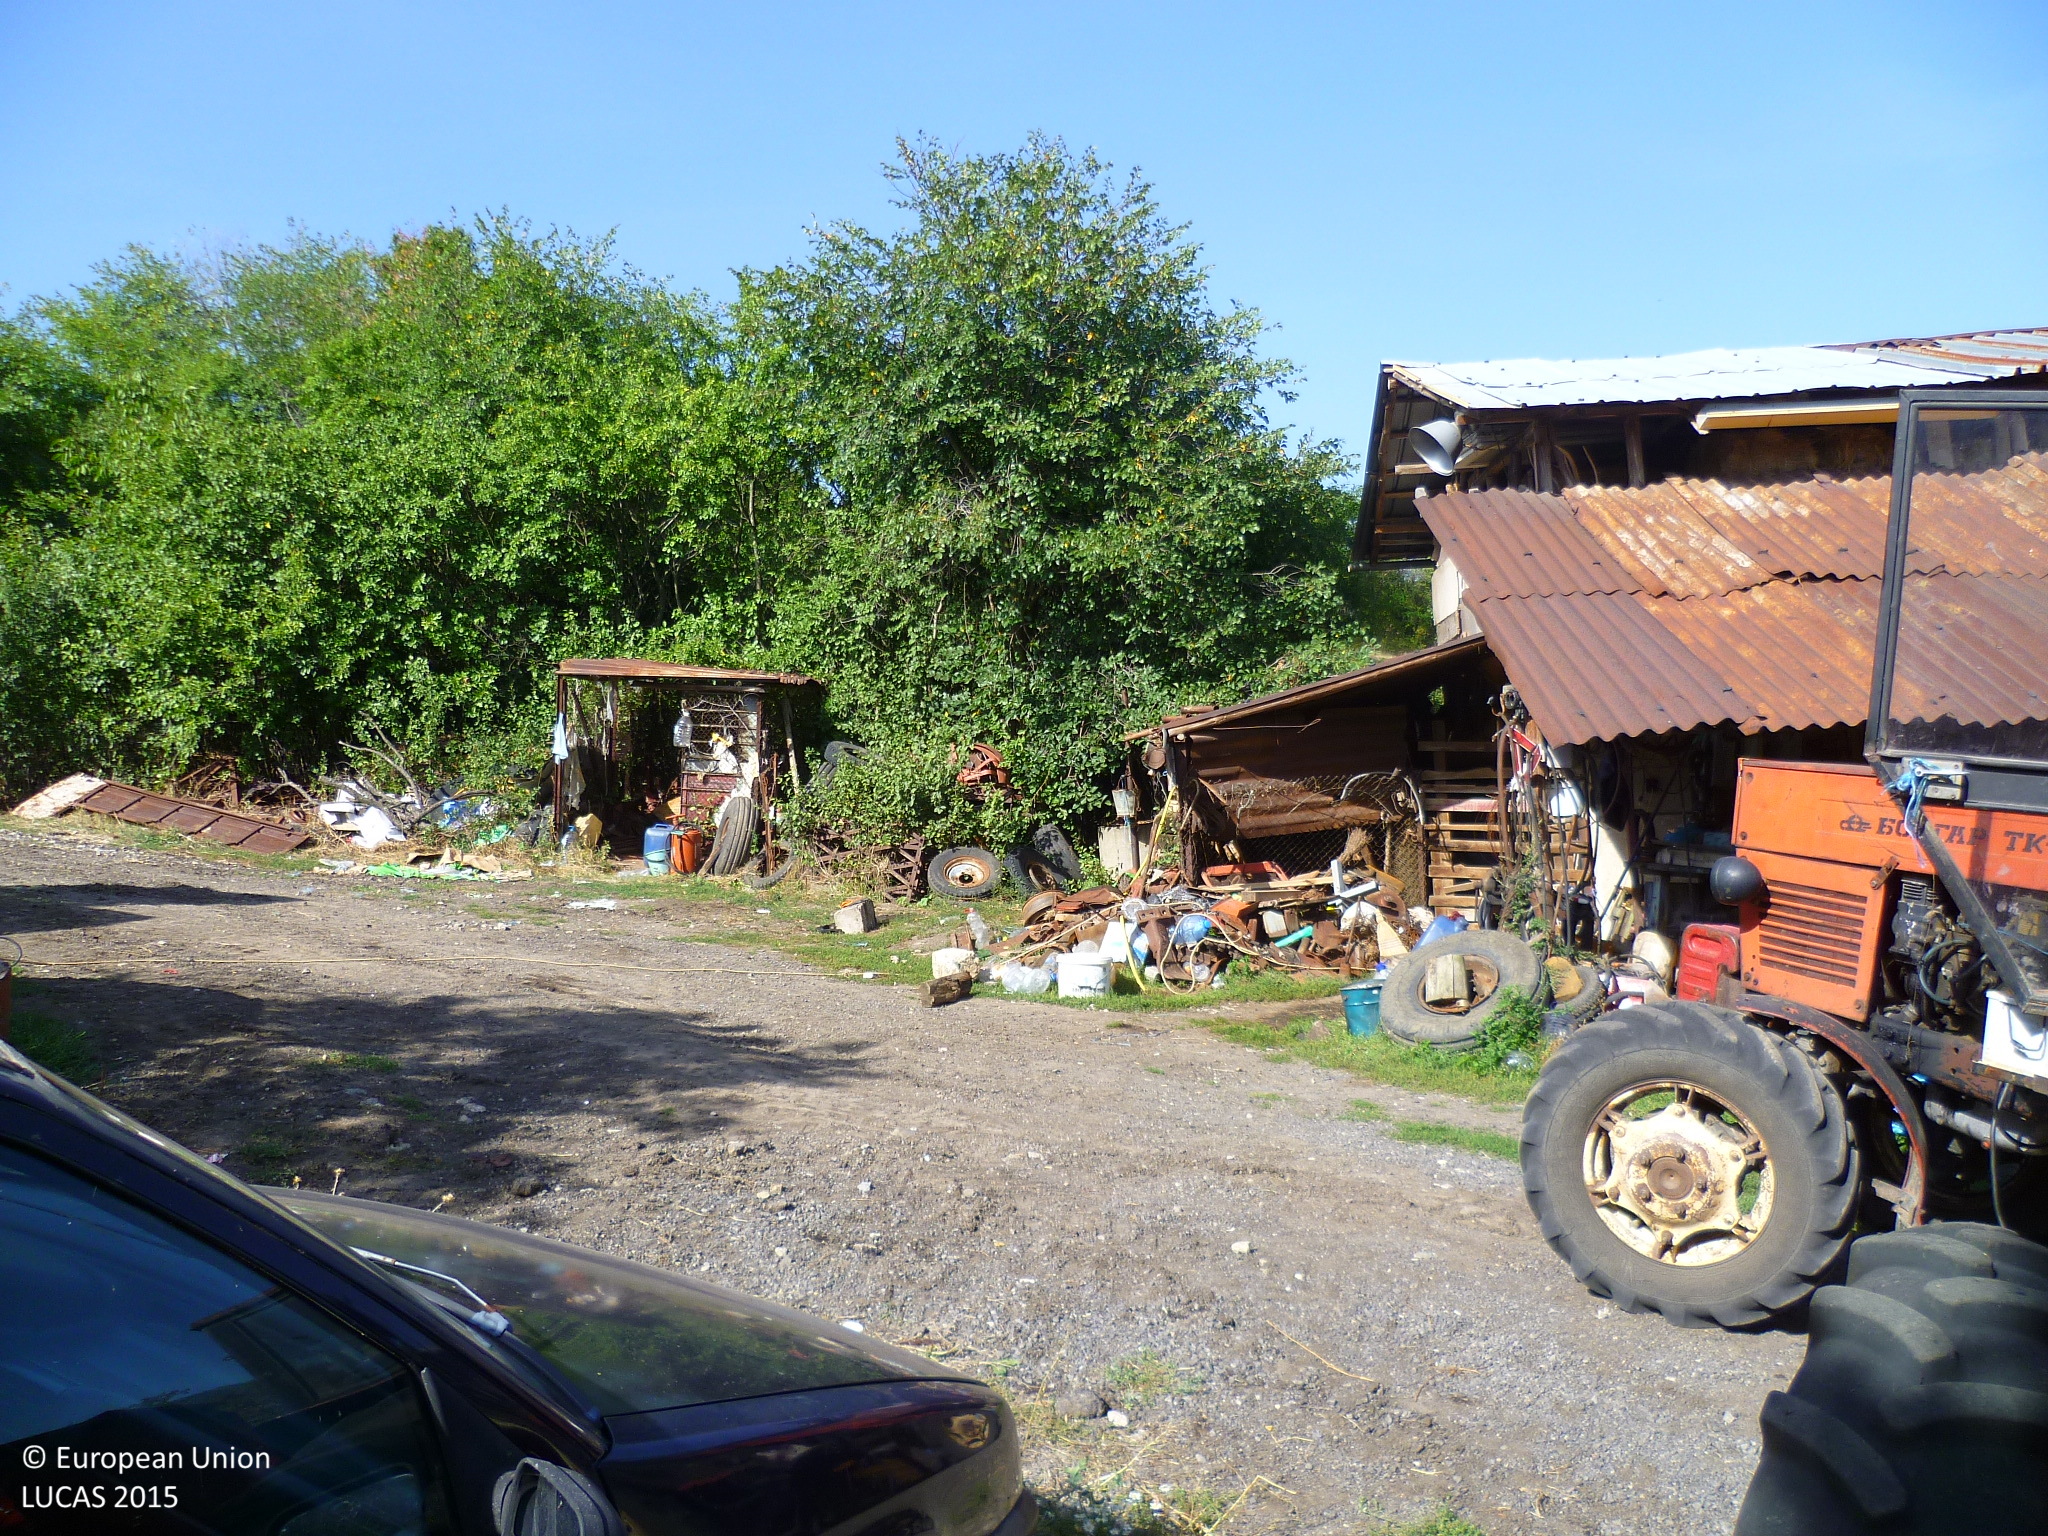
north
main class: Grassland
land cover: Grassland with sparse tree/shrub cover
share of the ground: 50 - 75 %
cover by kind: herbaceous plants 60 %, unconsolidated bare surface 30 %, broadleaved forest trees 5 %, shrubs 5 %
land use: Residential
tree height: > 5 m
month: September
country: BG
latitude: 42.6646
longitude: 23.0481
